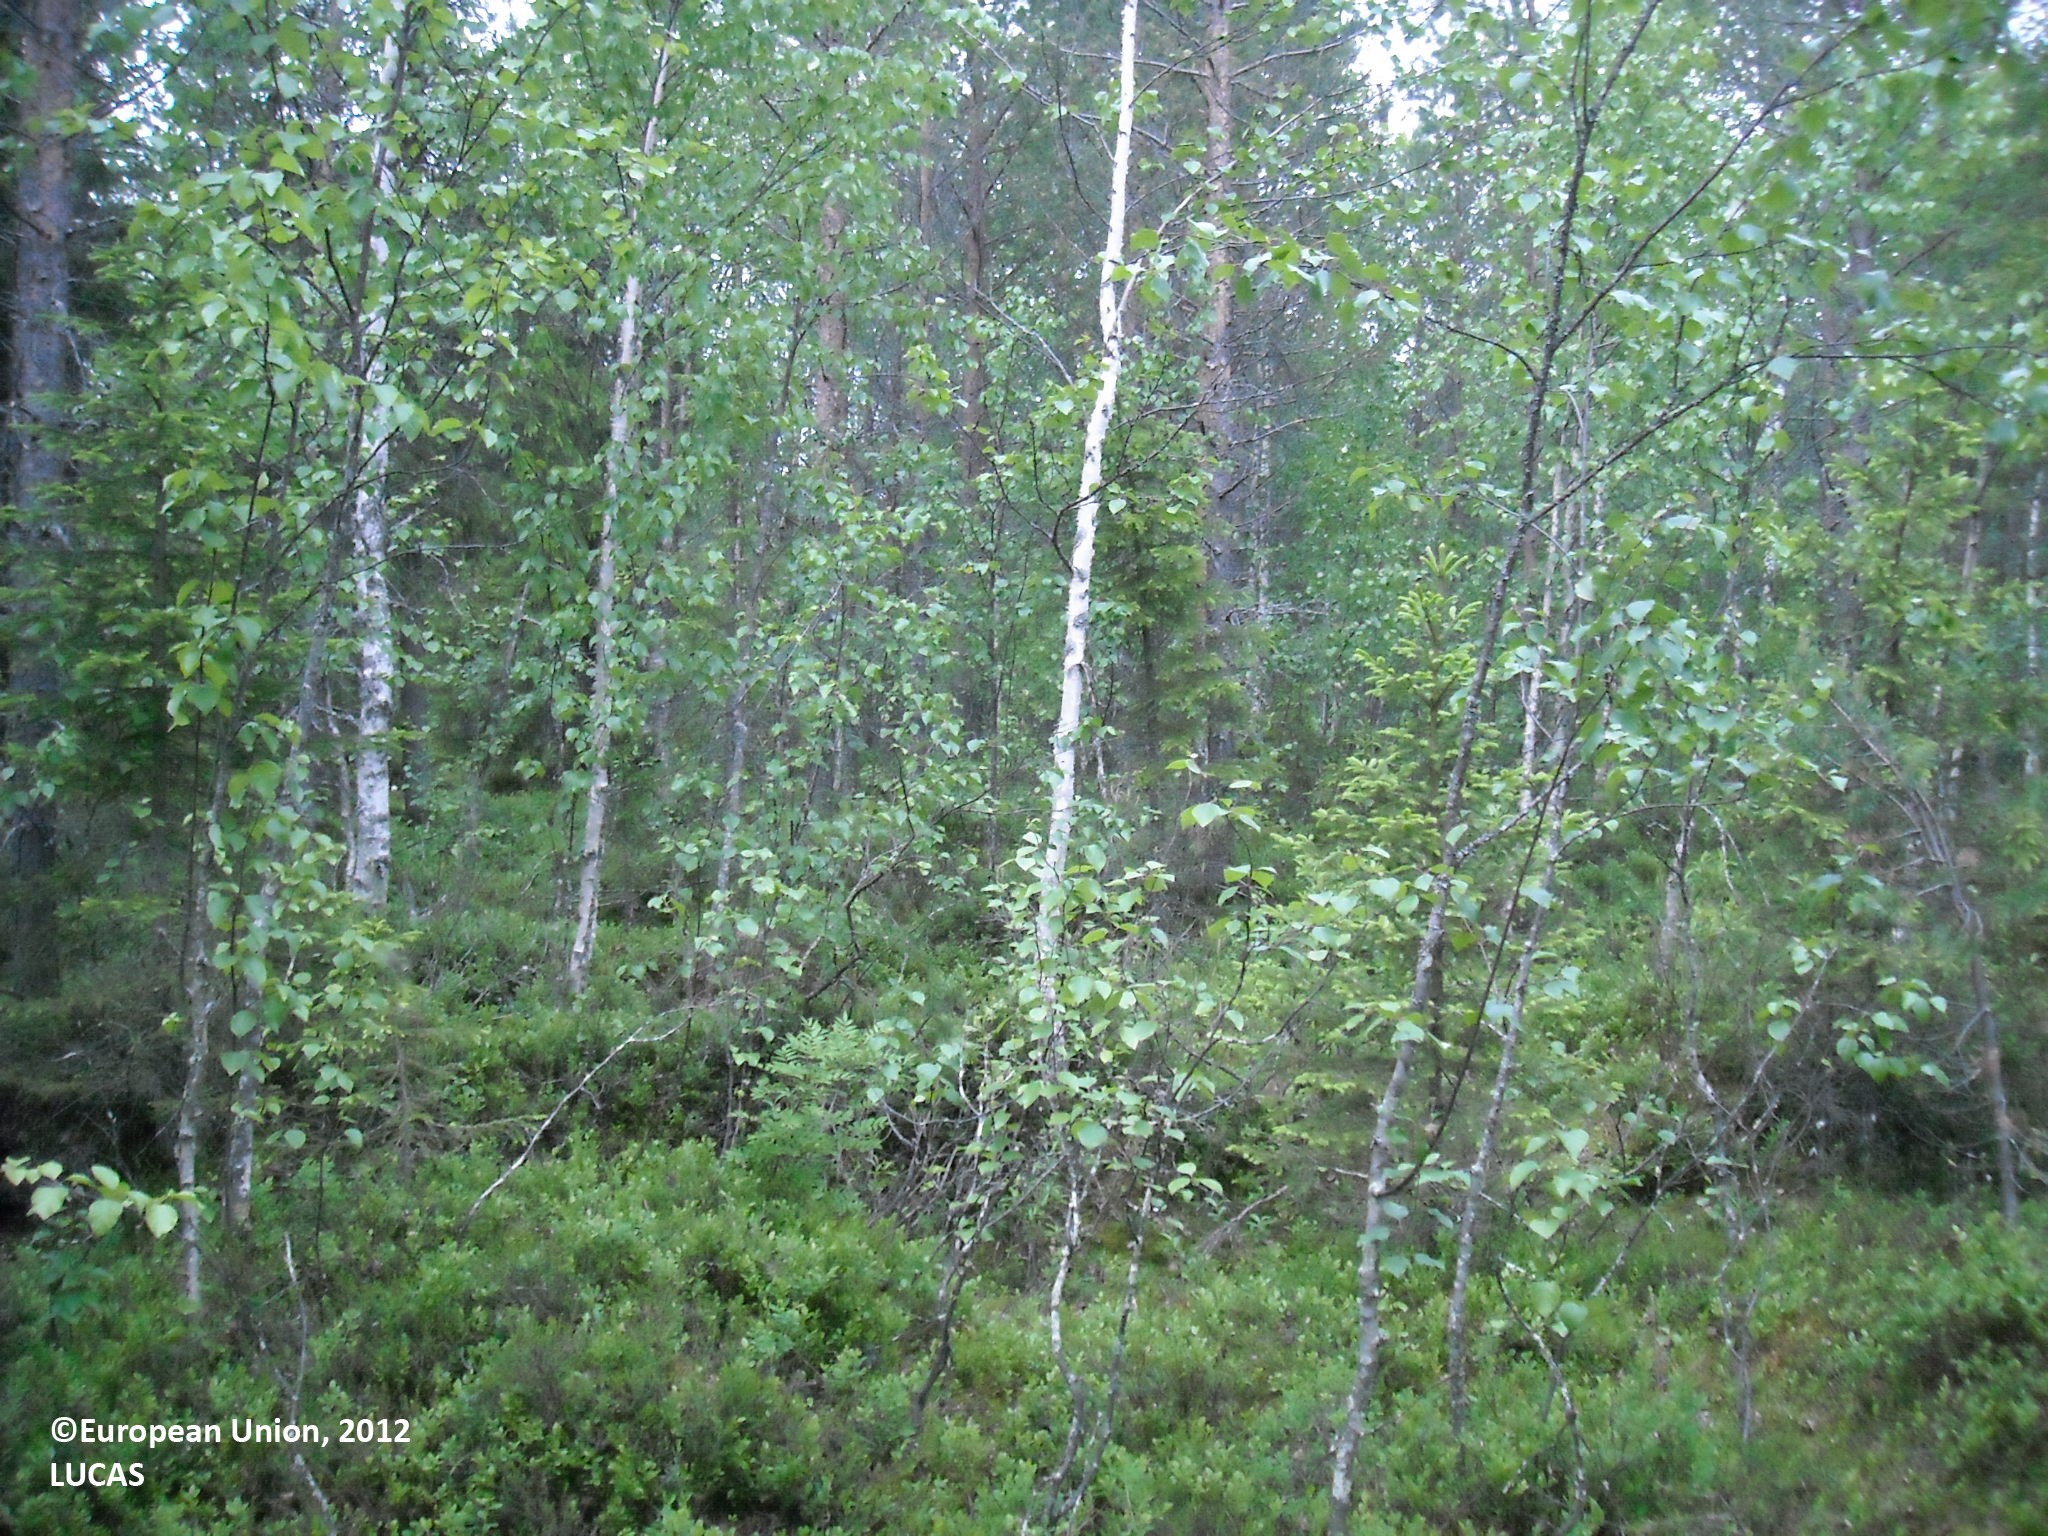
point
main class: Woodland
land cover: Other mixed woodland
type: boreal forest
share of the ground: > 75 %
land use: Forestry
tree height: > 5 m
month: June
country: FI
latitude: 64.9236
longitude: 27.9788
